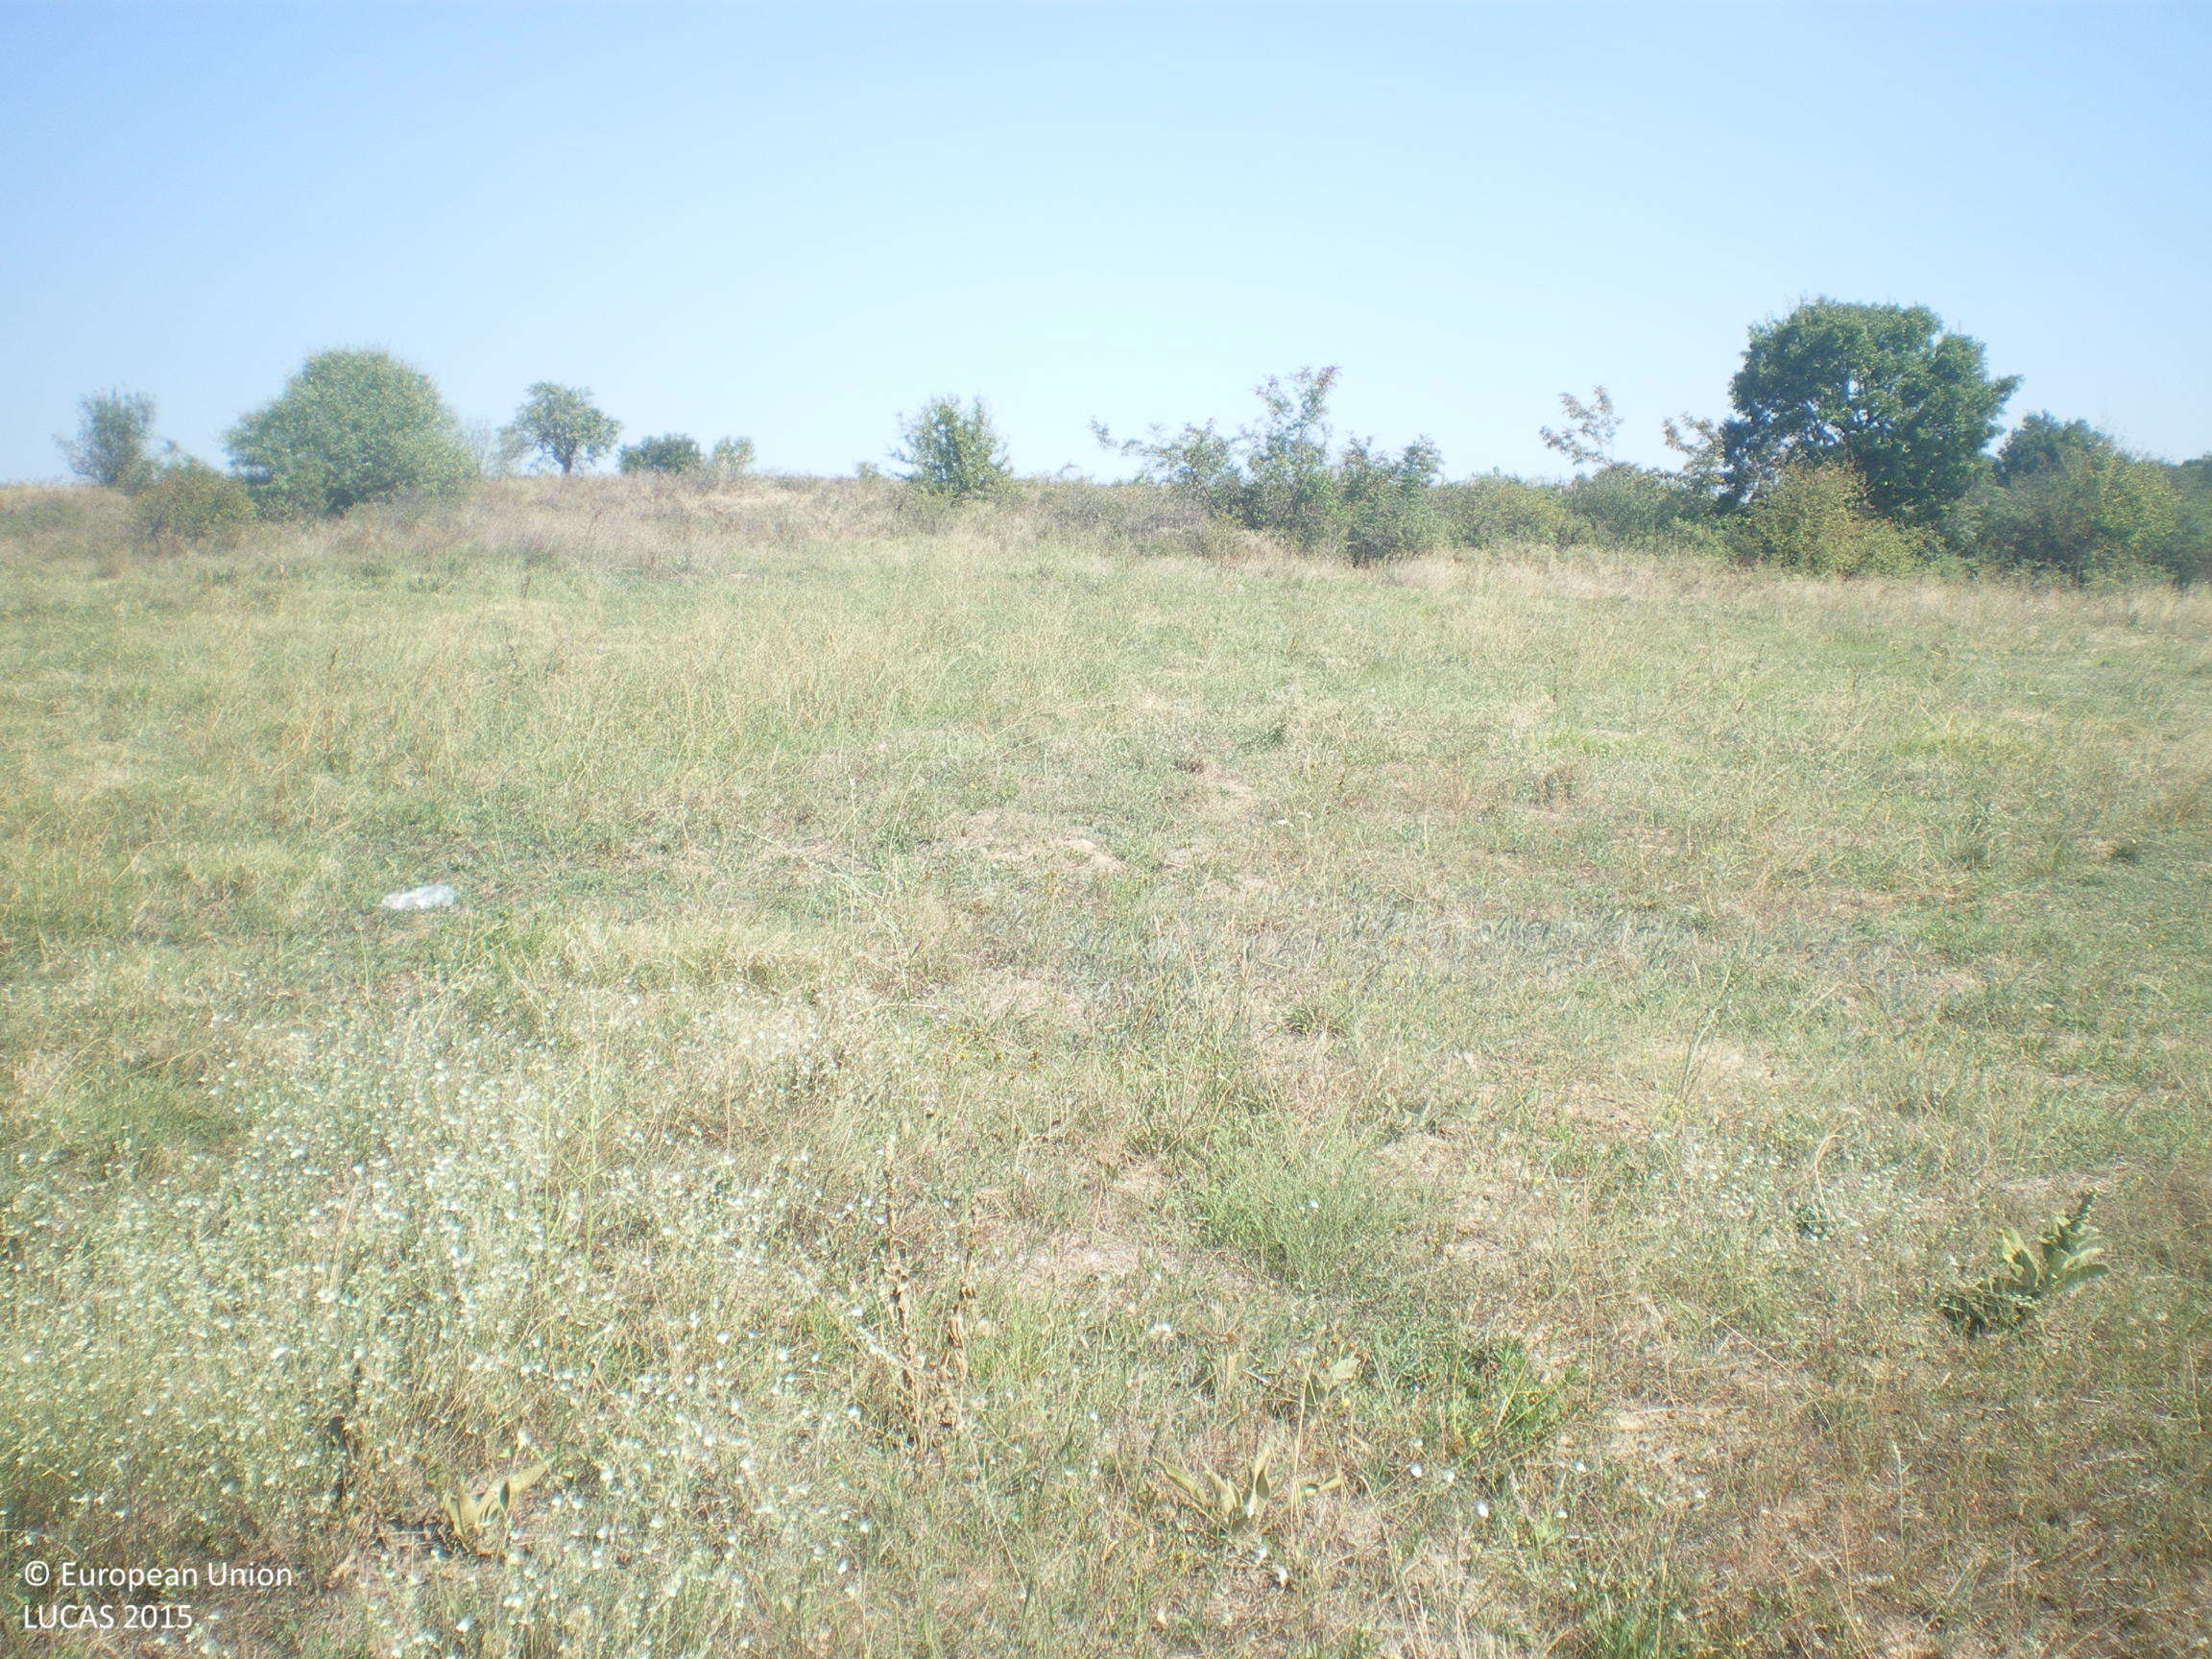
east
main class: Grassland
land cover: Grassland with sparse tree/shrub cover
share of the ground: > 75 %
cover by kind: herbaceous plants 90 %, broadleaved forest trees 5 %, shrubs 5 %
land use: Agriculture (excluding fallow land and kitchen gardens)
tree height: > 5 m
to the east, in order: Grassland with sparse tree/shrub cover; Grassland without tree/shrub cover; Grassland with sparse tree/shrub cover; Tracks; Grassland without tree/shrub cover; Tracks; Grassland without tree/shrub cover; Fences; Vineyards; Fences; Grassland with sparse tree/shrub cover
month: August
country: BG
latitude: 42.0428
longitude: 26.0593
